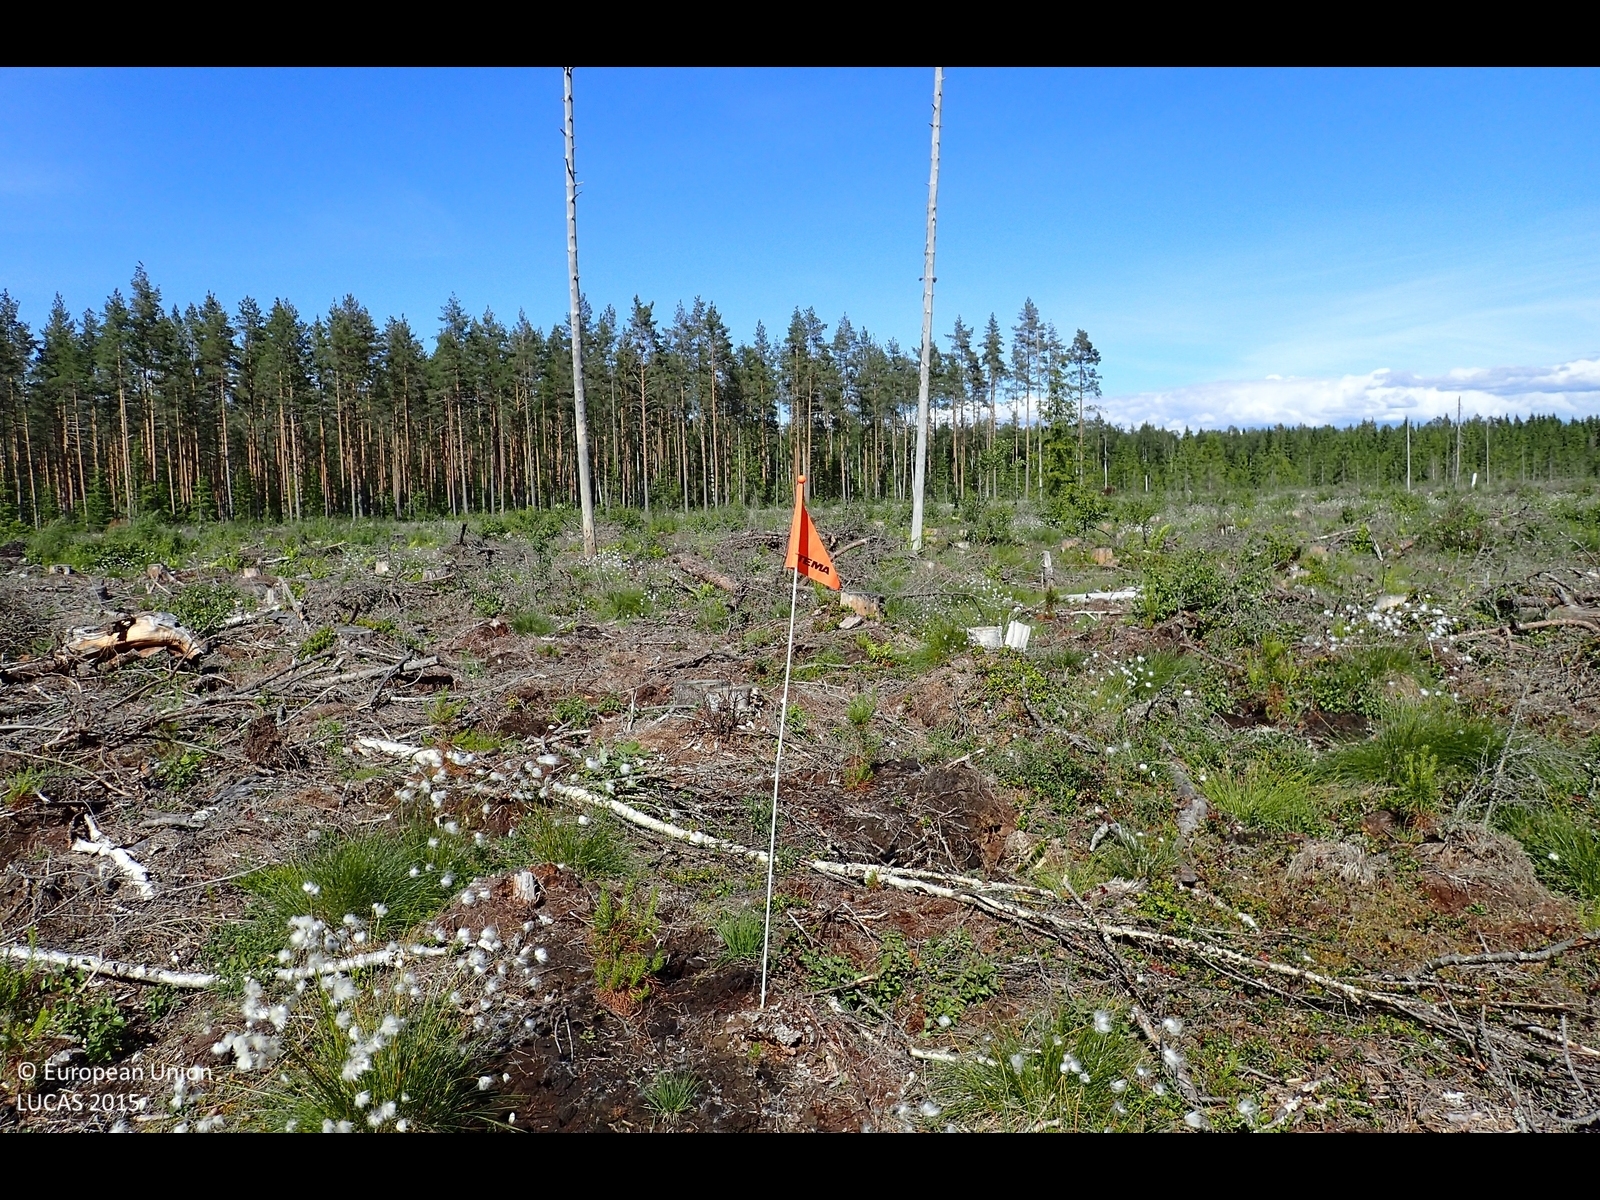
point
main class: Woodland
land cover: Broadleaved woodland
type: mire and swamp forests
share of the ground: 10 - 25 %
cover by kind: unconsolidated bare surface 25 %, herbaceous plants 15 %, broadleaved forest trees 10 %, shrubs 5 %
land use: Forestry
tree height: < 5 m
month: July
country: FI
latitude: 62.5922
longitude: 21.7091
